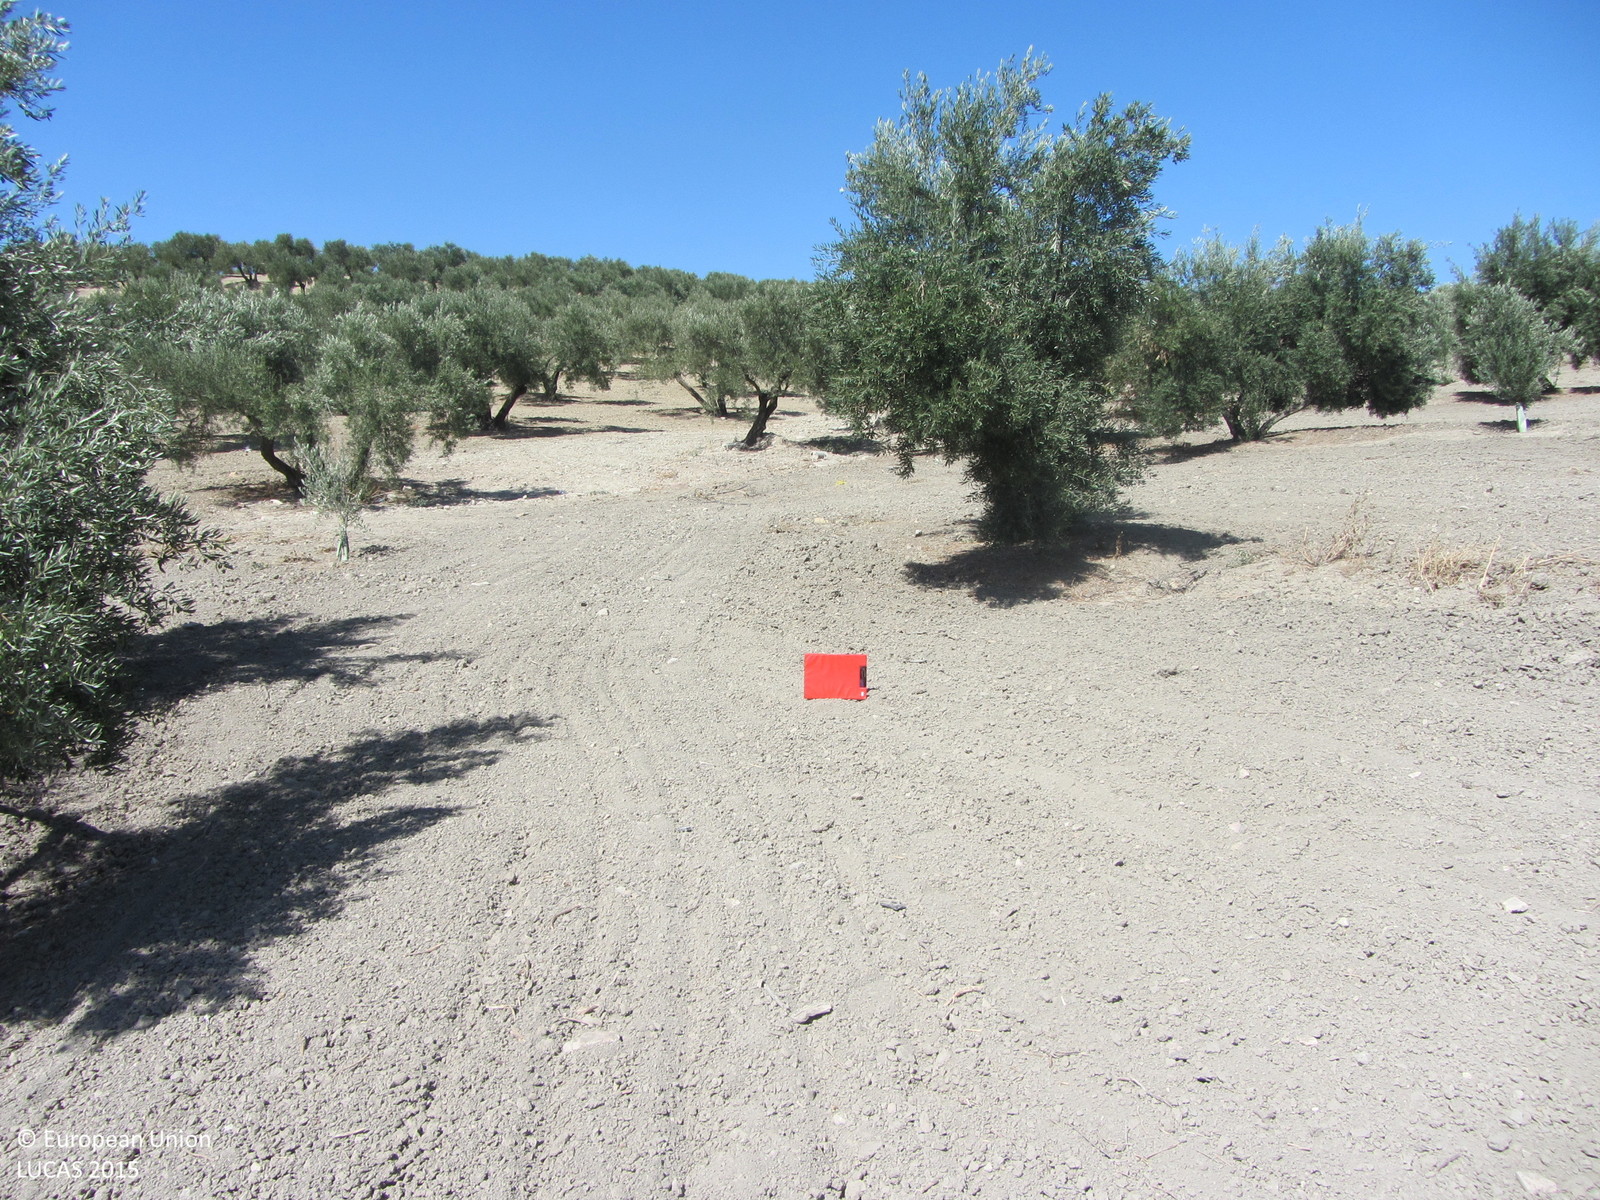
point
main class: Cropland
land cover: Olive groves
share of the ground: 10 - 25 %
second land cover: Other bare soil
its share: > 75 %
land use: Agriculture (excluding fallow land and kitchen gardens)
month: July
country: ES
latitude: 37.9907
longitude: -3.8852
